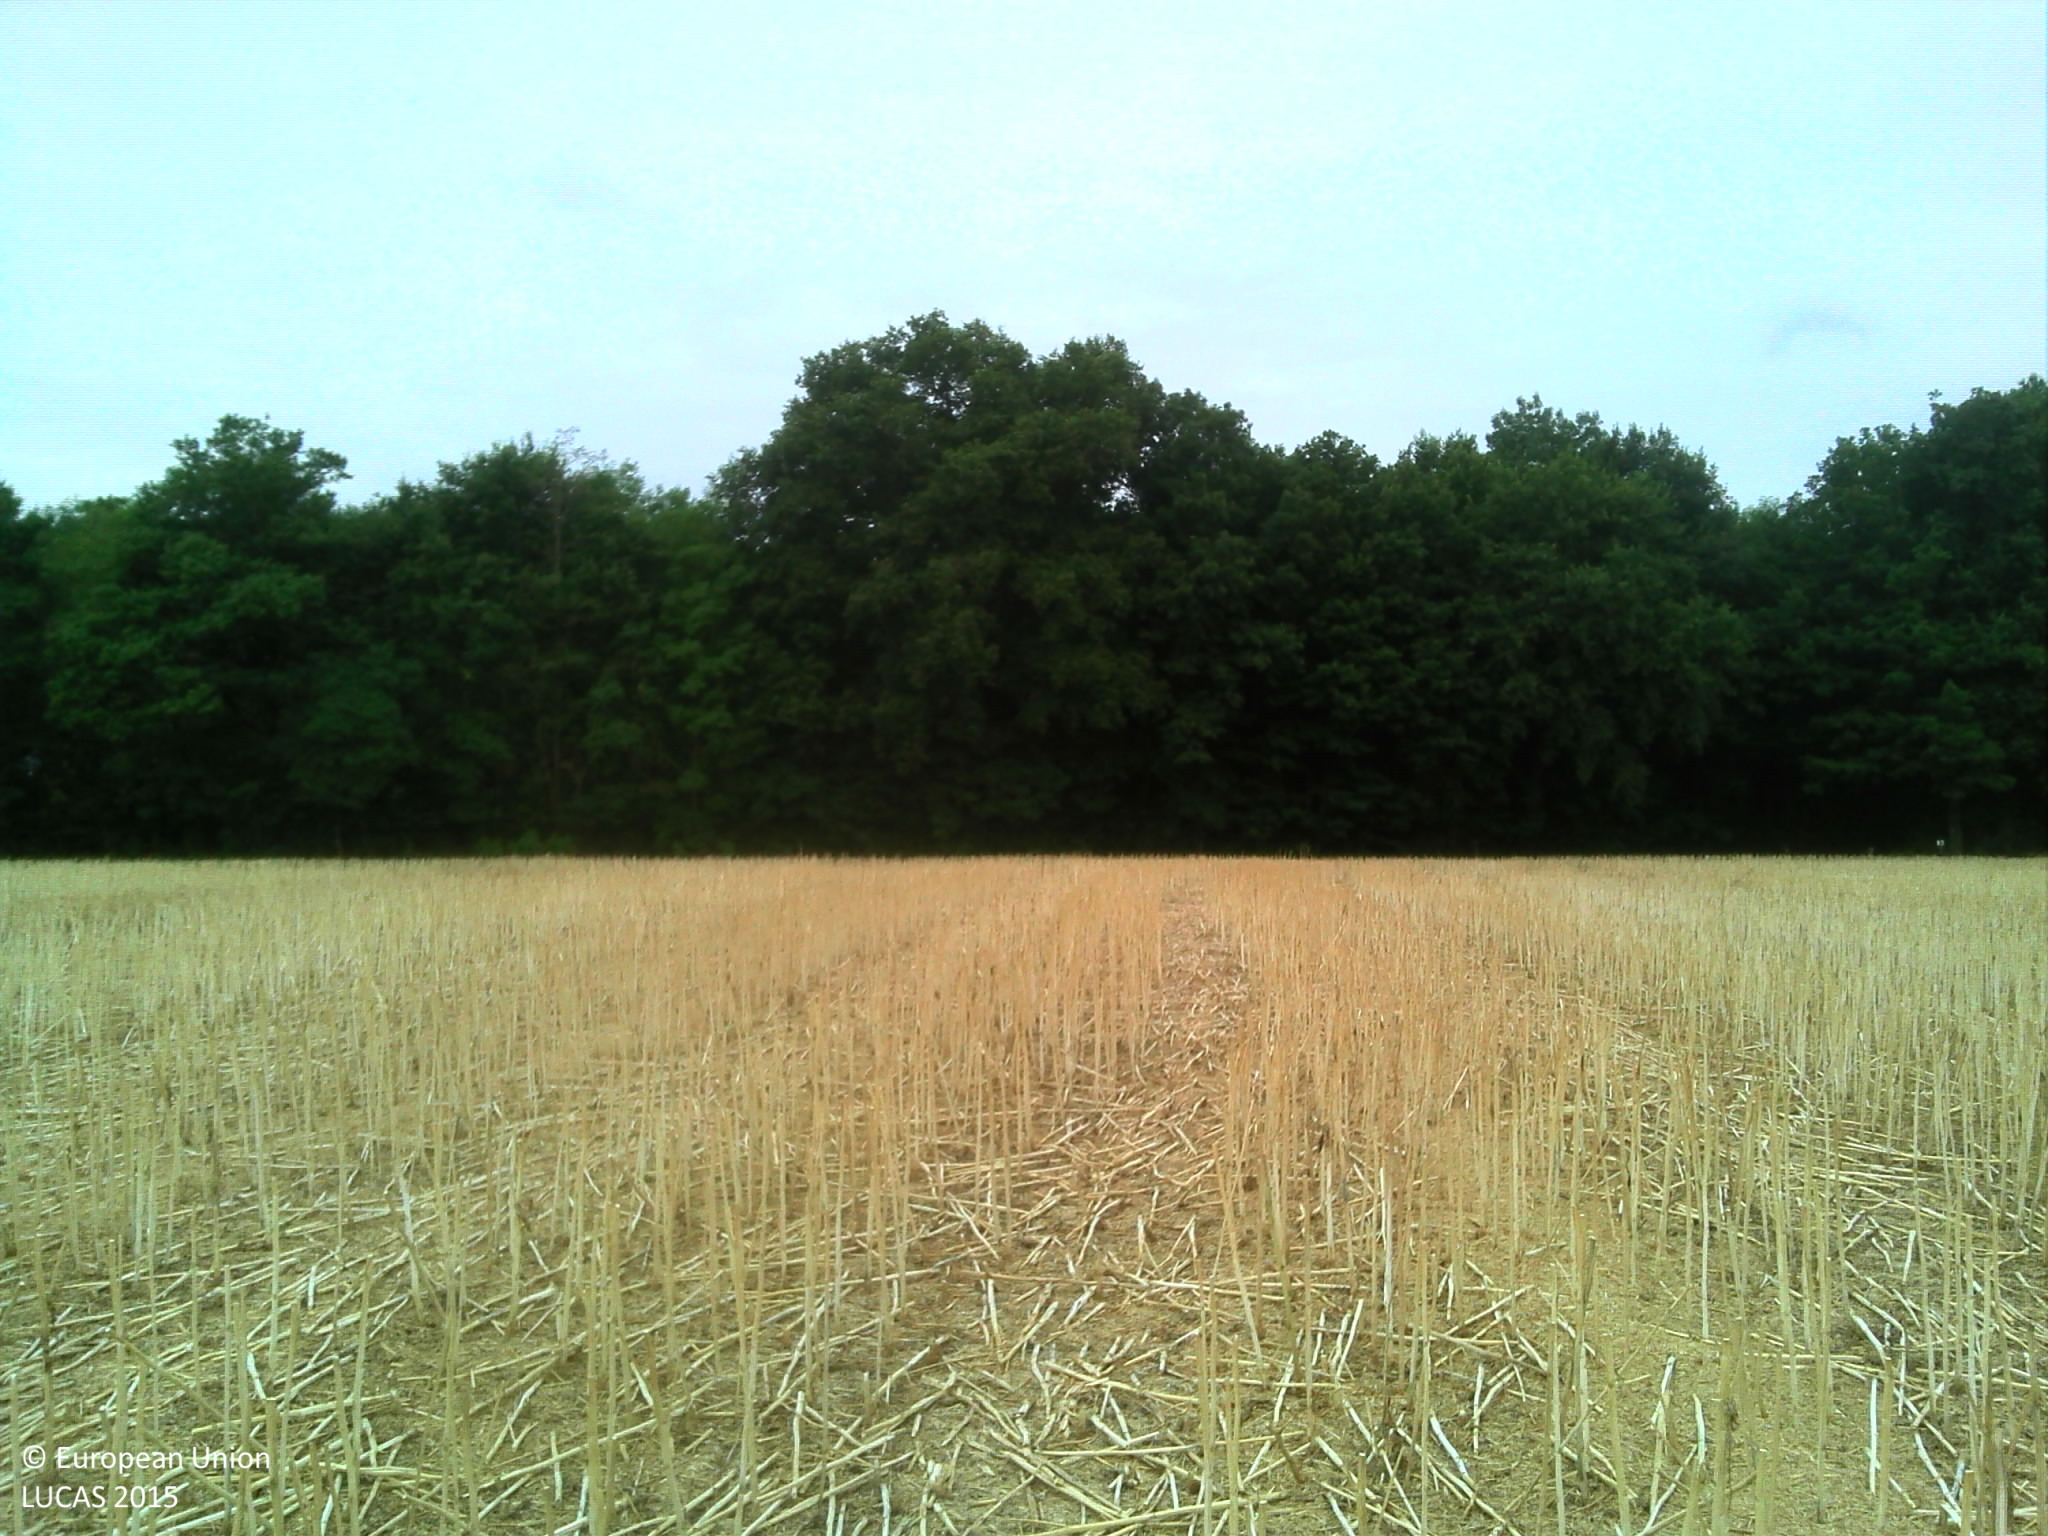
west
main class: Cropland
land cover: Rape and turnip rape
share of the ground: < 10 %
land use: Agriculture (excluding fallow land and kitchen gardens)
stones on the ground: < 10 %
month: July
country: FR
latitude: 46.8778
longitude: 4.8707
